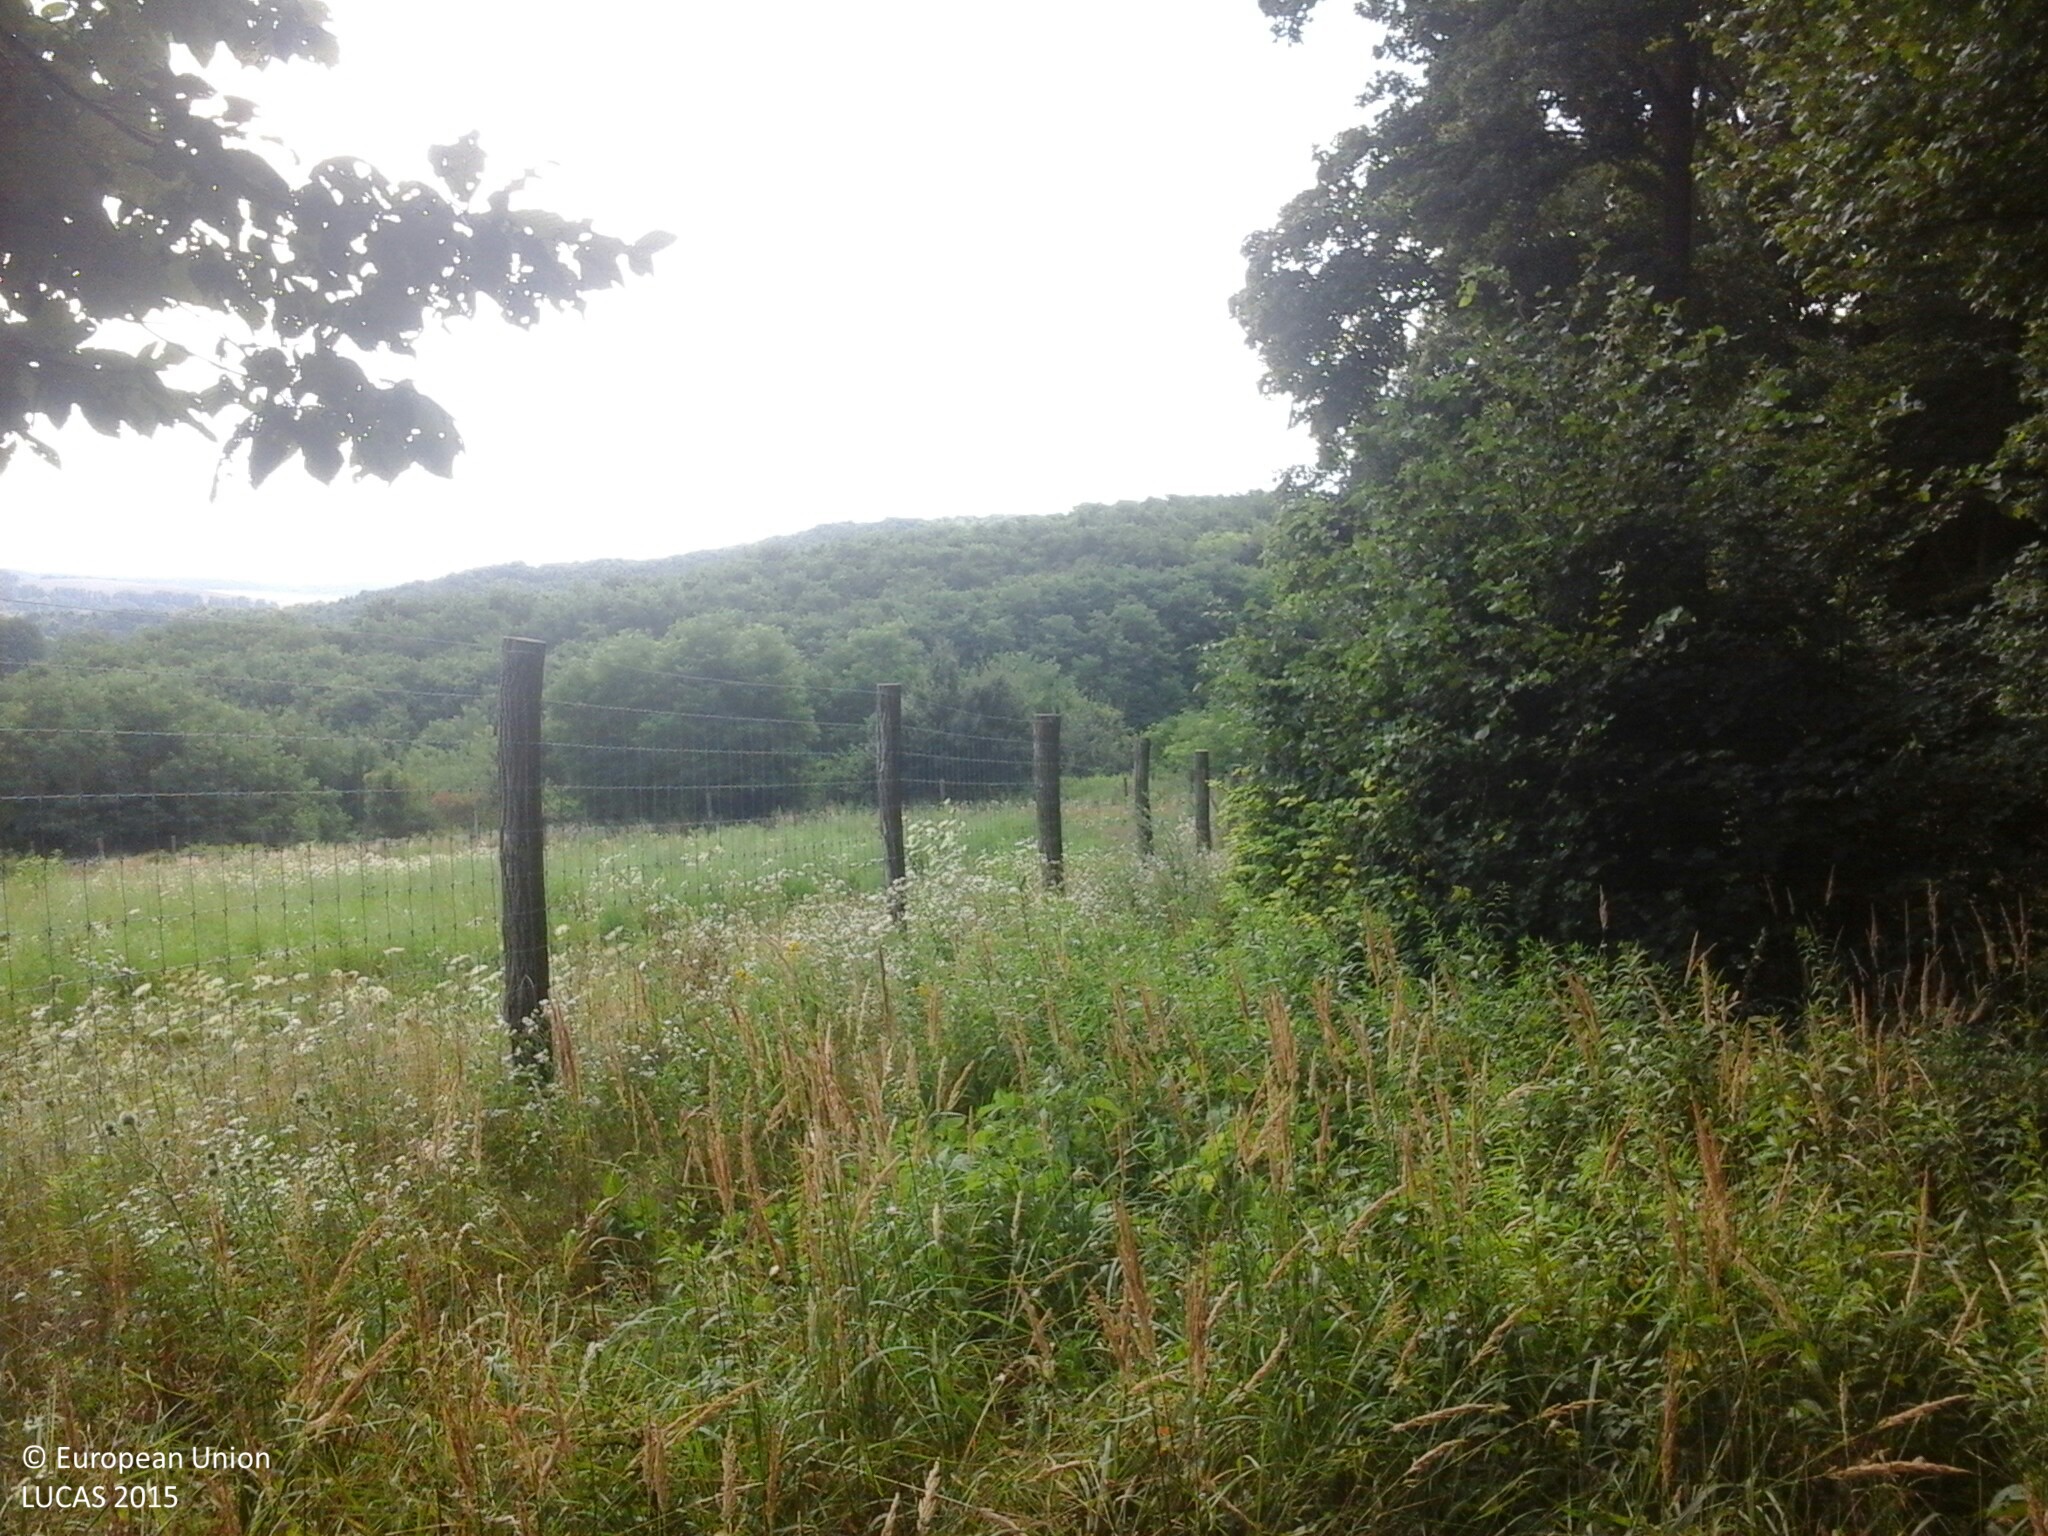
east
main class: Grassland
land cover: Grassland without tree/shrub cover
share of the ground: > 75 %
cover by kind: herbaceous plants 100 %
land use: Agriculture (excluding fallow land and kitchen gardens)
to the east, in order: Grassland without tree/shrub cover; Fences; Grassland without tree/shrub cover; Fences; Shrubland with sparse tree cover; Spontaneously vegetated surfaces; Broadleaved woodland
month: July
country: HU
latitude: 47.3582
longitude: 17.9405
